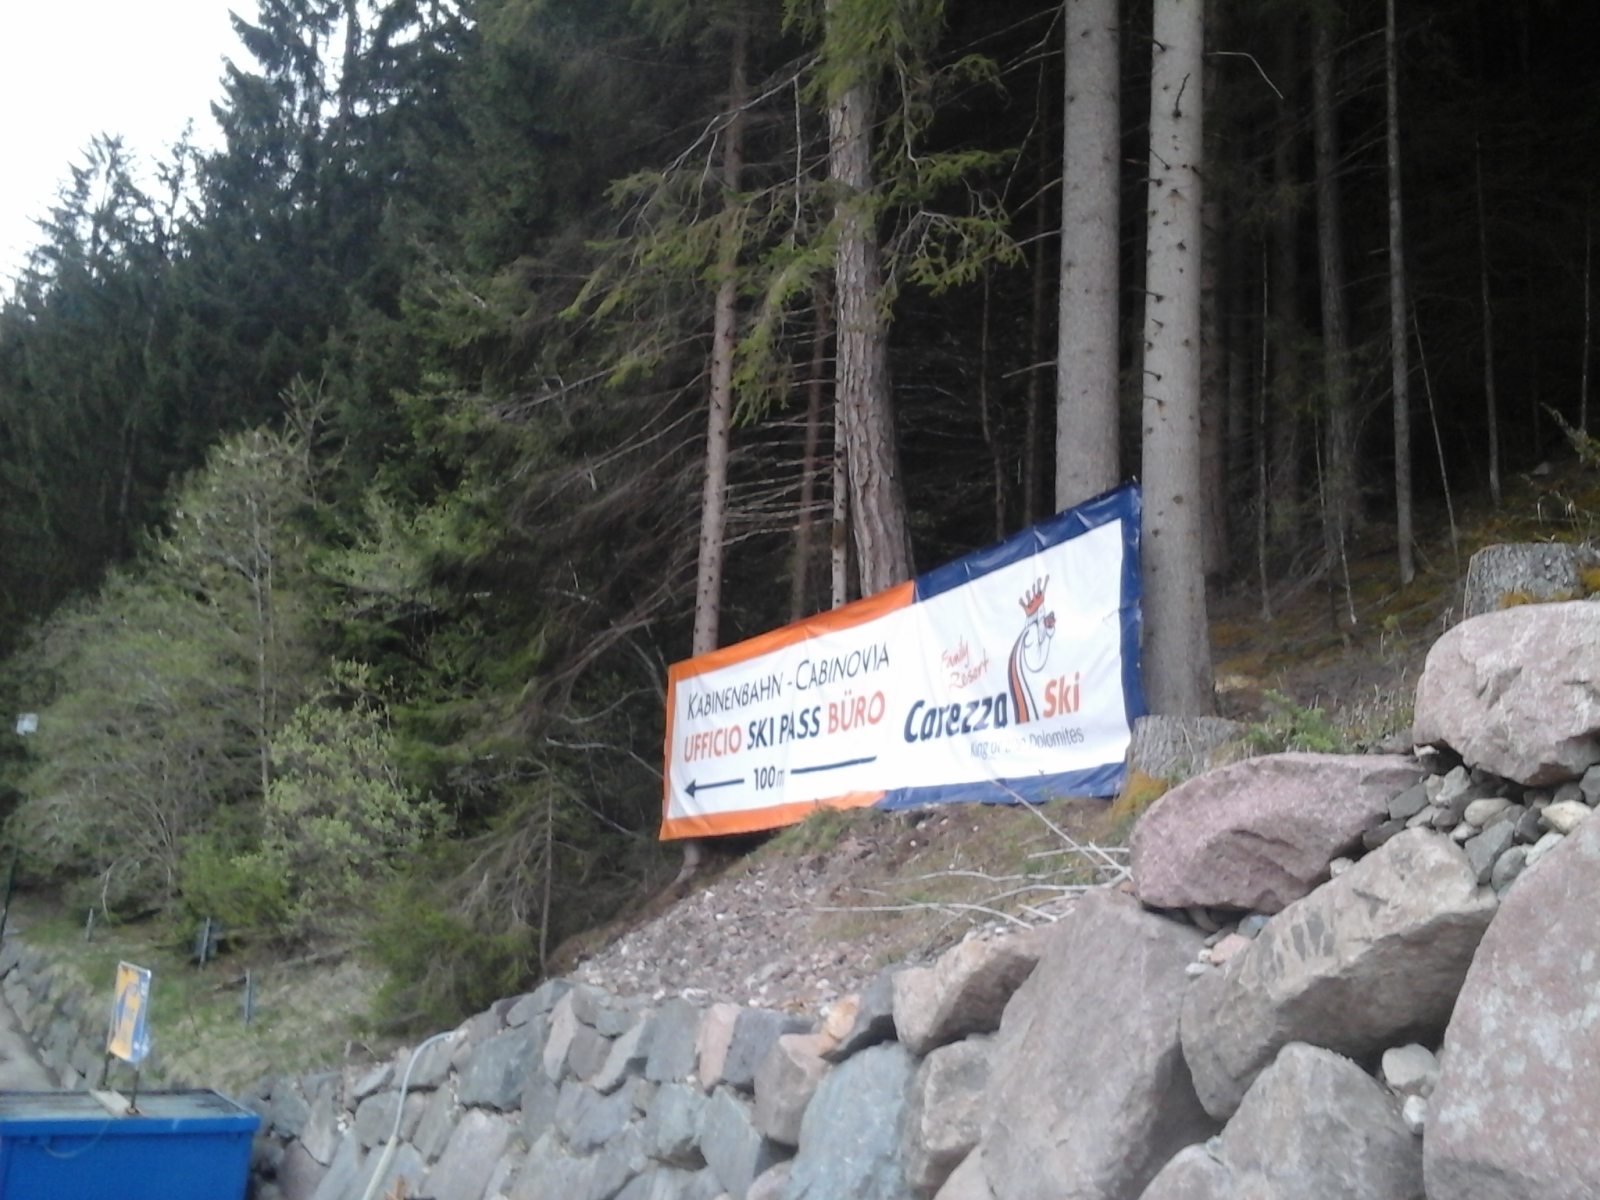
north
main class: Woodland
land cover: Spruce dominated coniferous woodland
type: alpine coniferous forest
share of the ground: > 75 %
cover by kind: coniferous forest trees 95 %, herbaceous plants 5 %
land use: Forestry
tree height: > 5 m
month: May
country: IT
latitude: 46.4301
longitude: 11.5467
